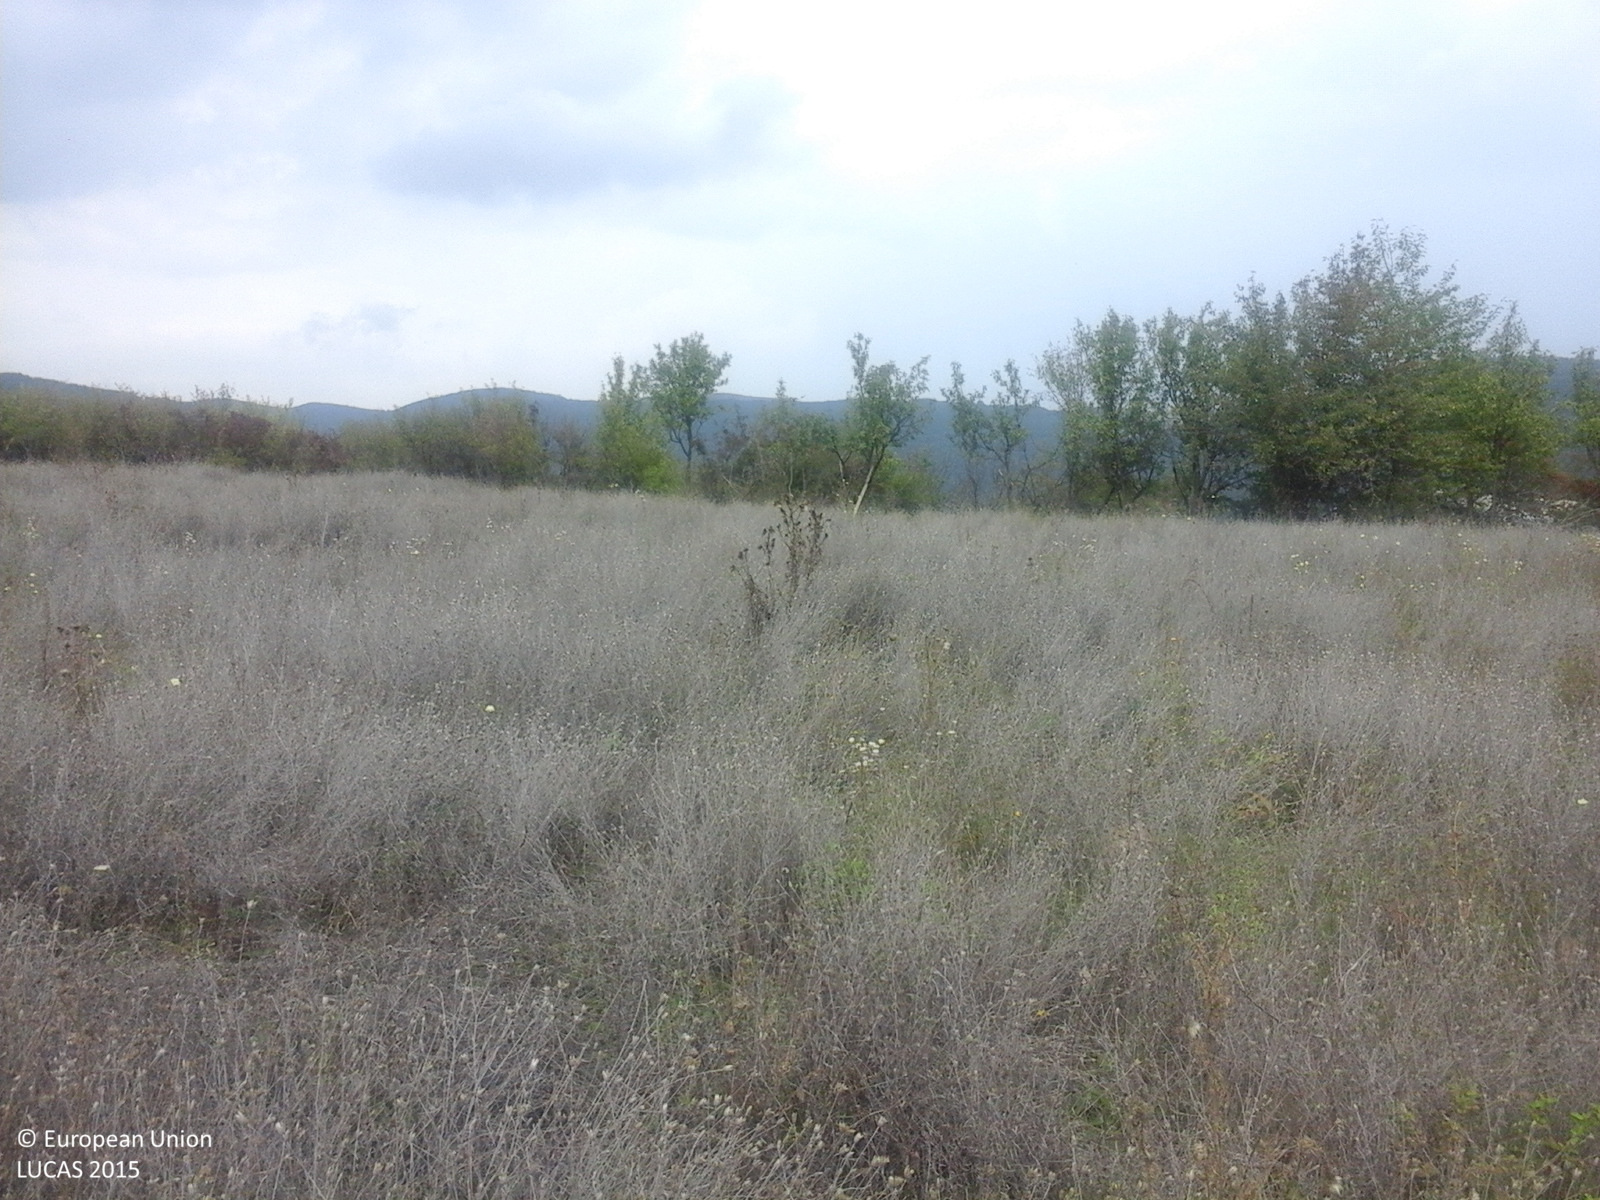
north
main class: Grassland
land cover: Spontaneously vegetated surfaces
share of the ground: > 75 %
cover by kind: herbaceous plants 100 %
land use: Agriculture (excluding fallow land and kitchen gardens)
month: October
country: RO
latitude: 46.1776
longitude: 23.5516
